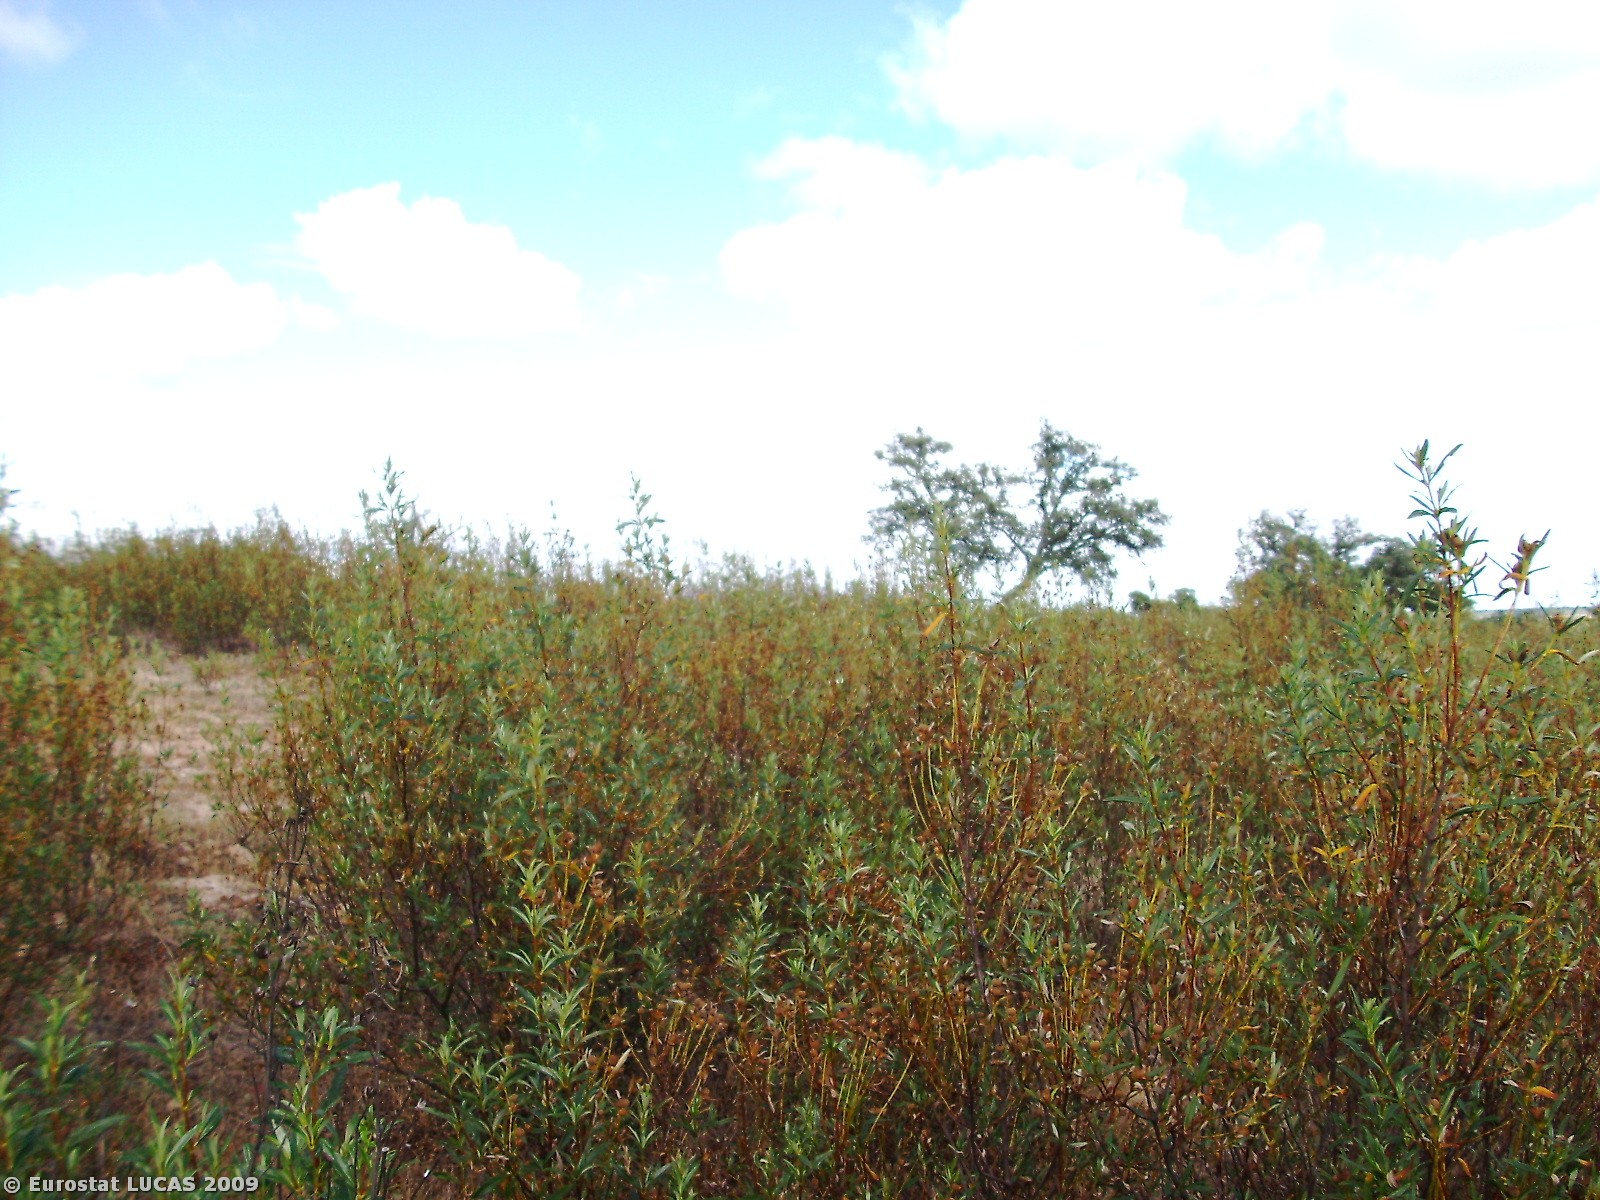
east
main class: Shrubland
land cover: Shrubland with sparse tree cover
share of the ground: > 75 %
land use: Fallow land
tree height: > 5 m
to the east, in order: Shrubland with sparse tree cover; Shrubland without tree cover
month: June
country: PT
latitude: 37.8371
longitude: -8.5276
